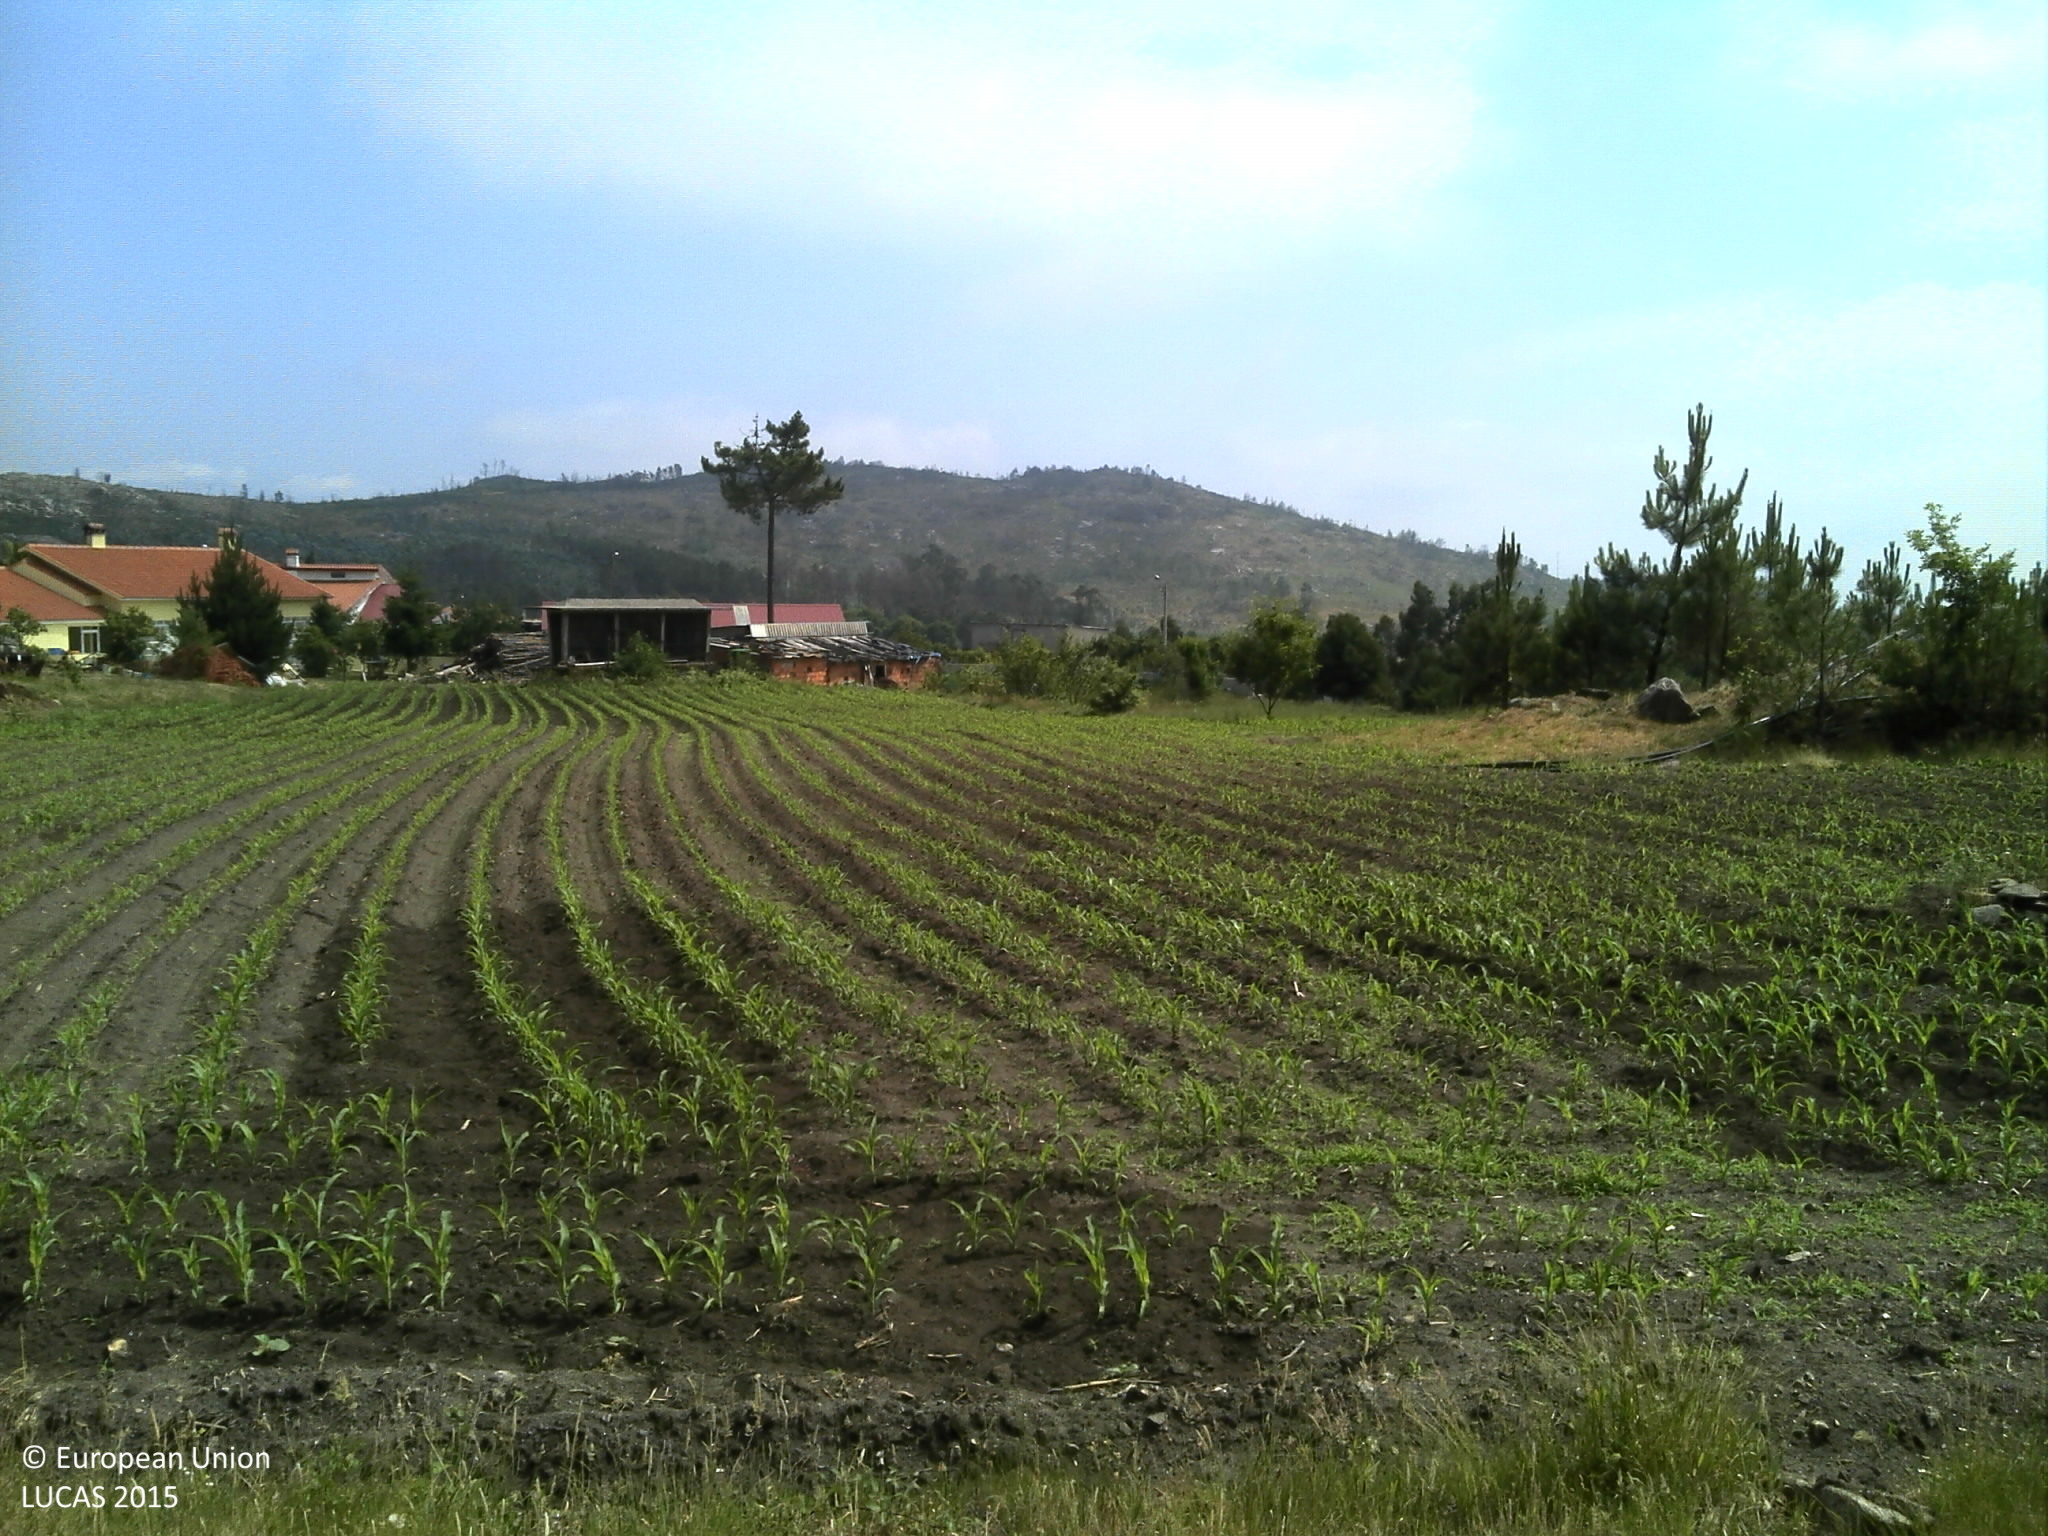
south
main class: Cropland
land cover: Maize
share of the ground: < 10 %
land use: Agriculture (excluding fallow land and kitchen gardens)
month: June
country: PT
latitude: 40.6926
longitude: -8.3003
